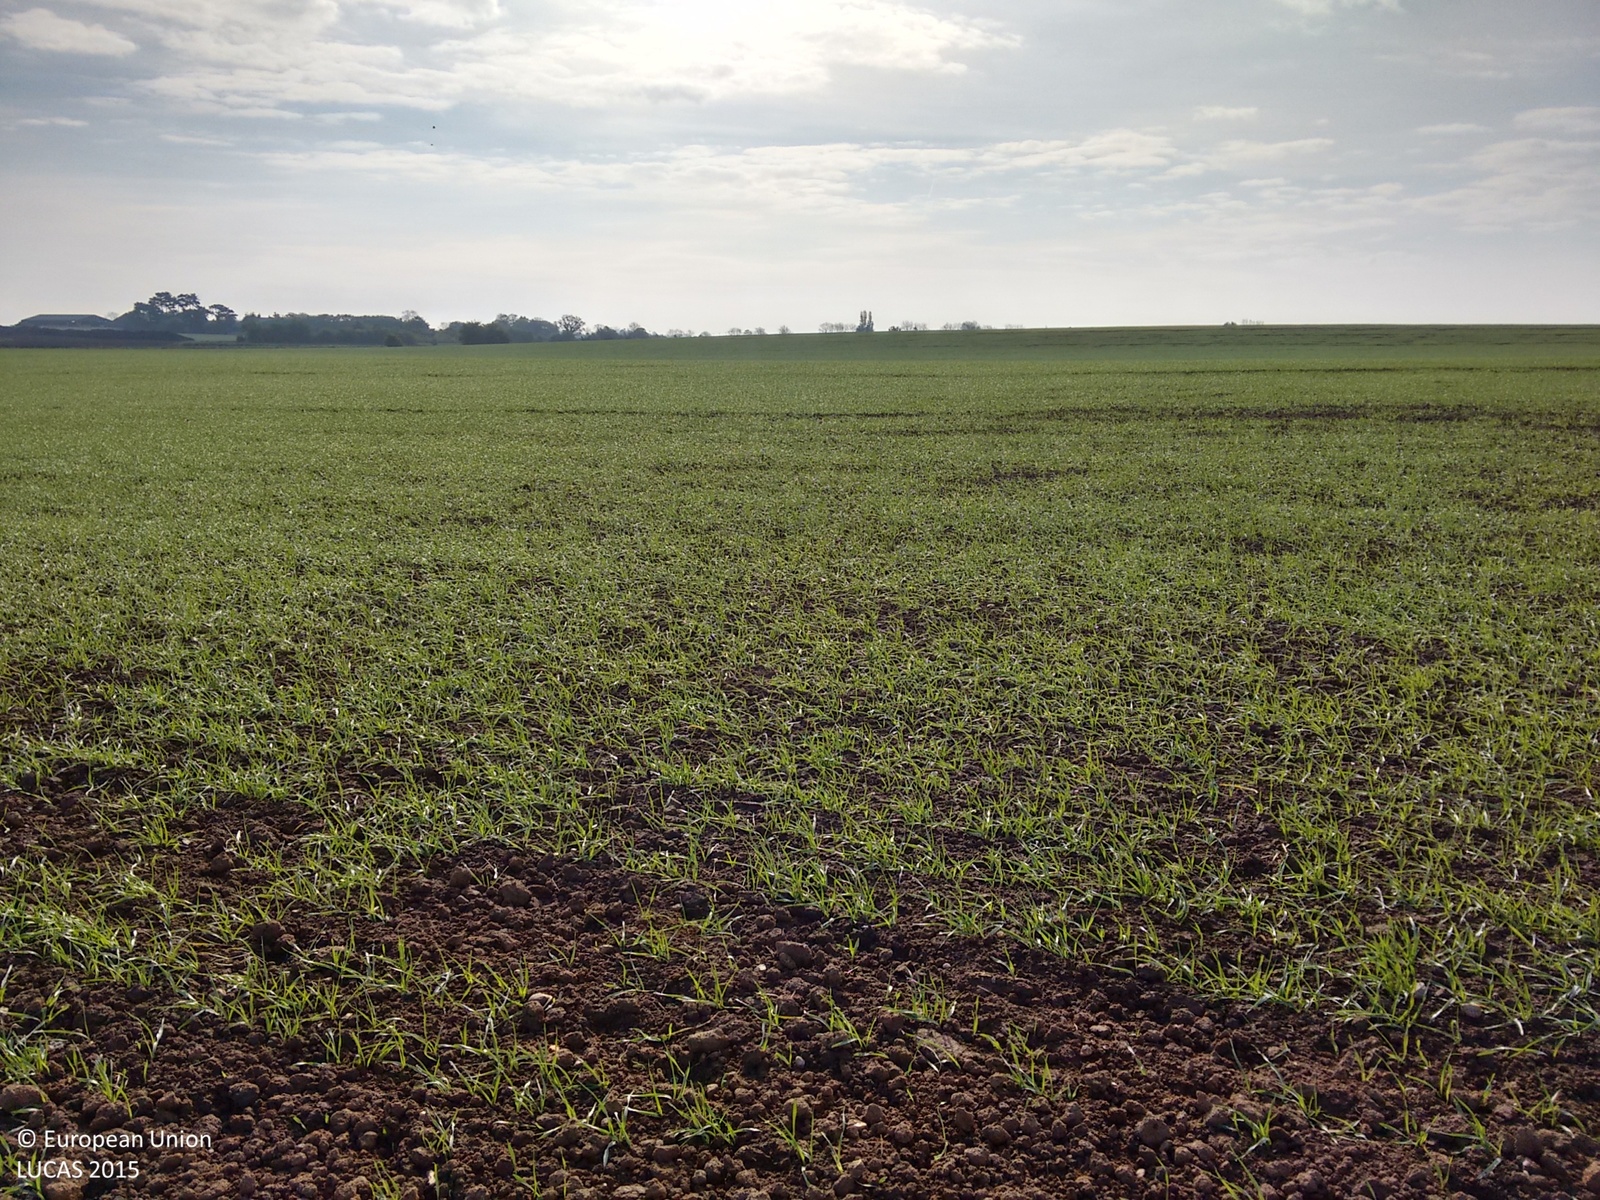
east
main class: Cropland
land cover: Barley
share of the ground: < 10 %
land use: Agriculture (excluding fallow land and kitchen gardens)
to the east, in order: Barley
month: May
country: GB
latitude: 53.2759
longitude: 0.2075
